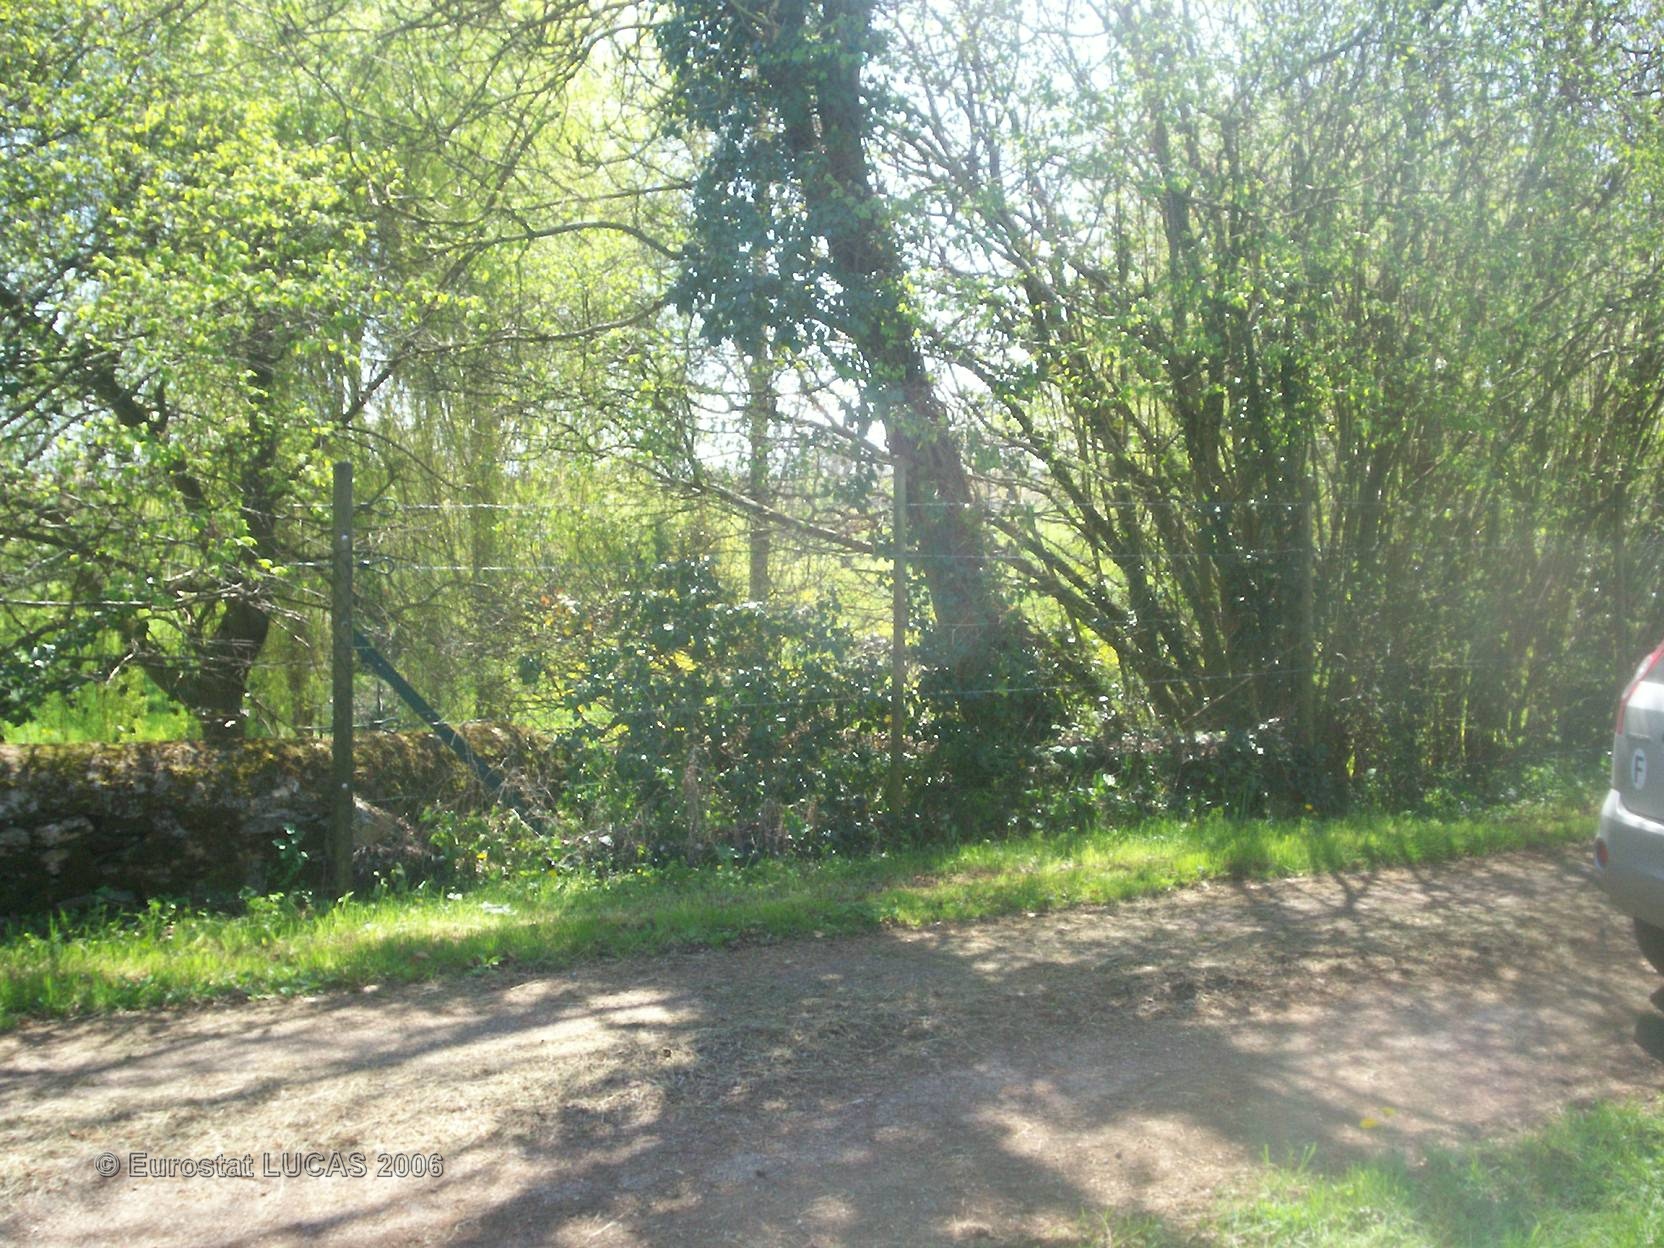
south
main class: Grassland
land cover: Grassland with sparse tree/shrub cover
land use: Fallow land
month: April
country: FR
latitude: 44.3622
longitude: 1.9329
